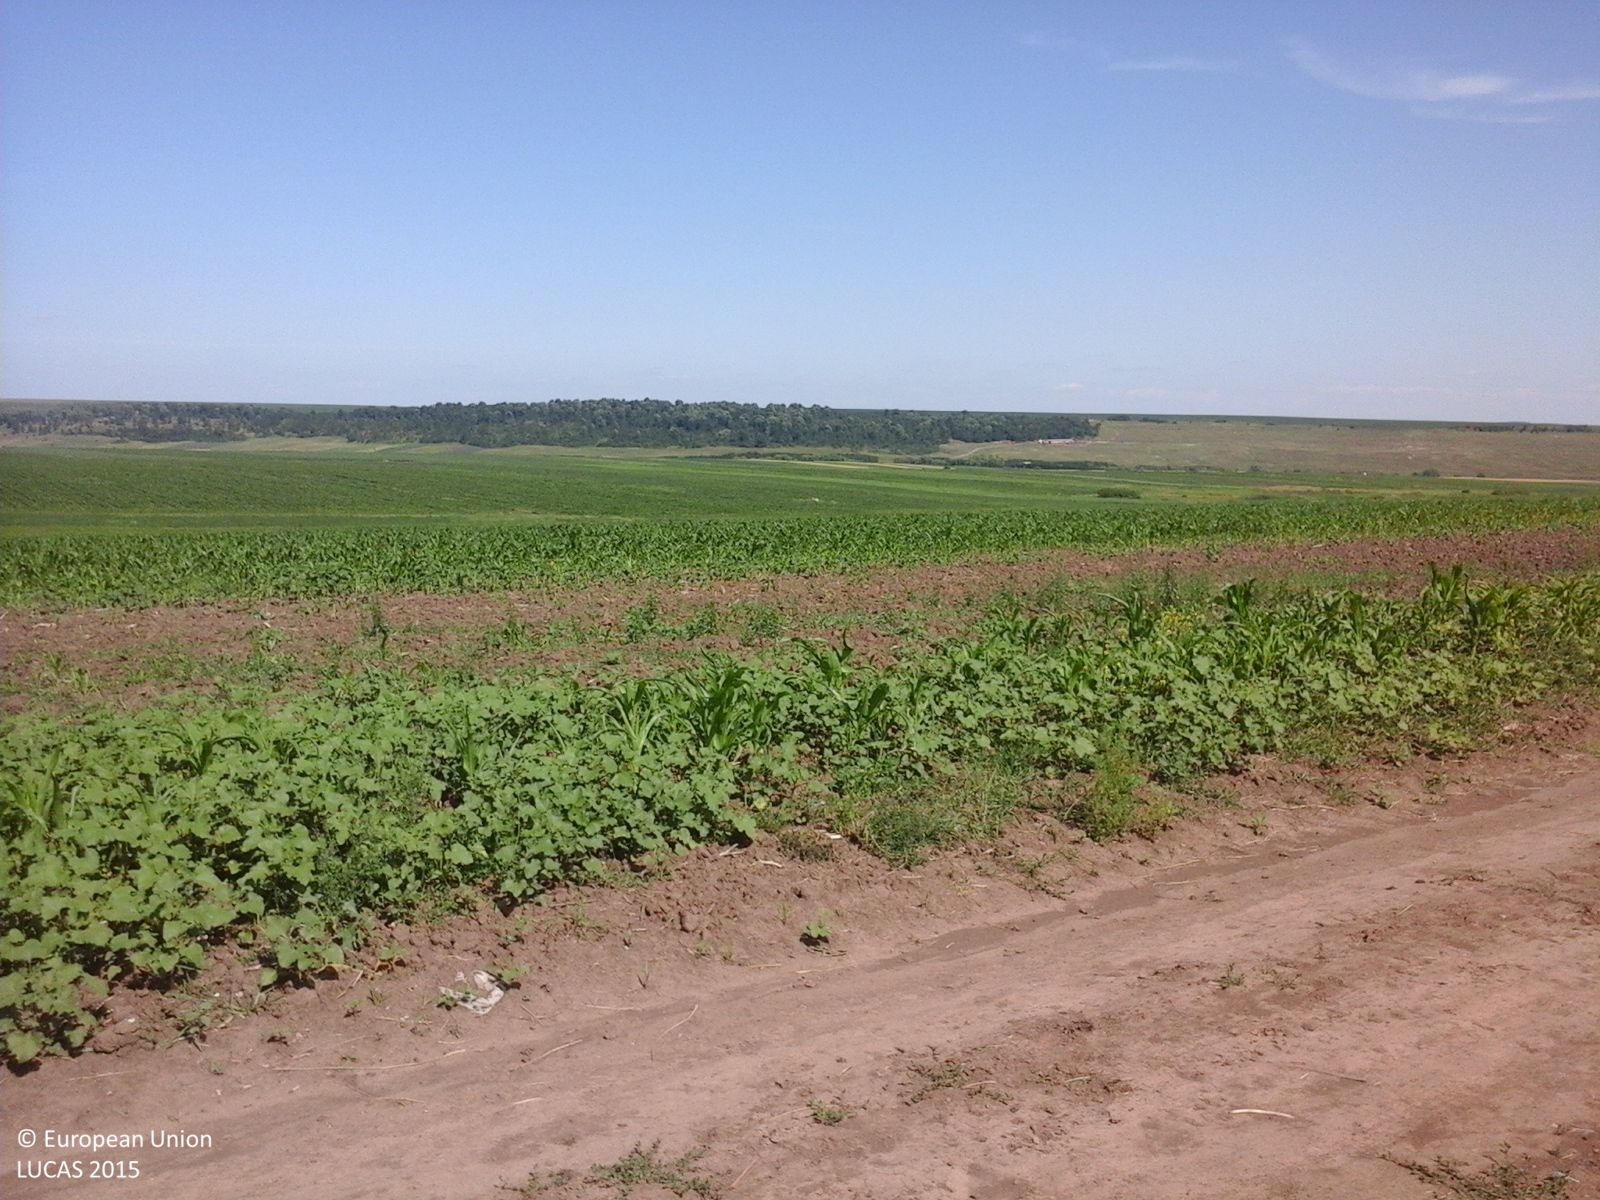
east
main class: Cropland
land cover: Lucerne
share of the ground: > 75 %
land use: Agriculture (excluding fallow land and kitchen gardens)
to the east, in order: Lucerne; Tracks; Shruby margins; Maize; Other bare soil; Maize; Lucerne
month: June
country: RO
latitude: 47.1299
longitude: 26.8791
